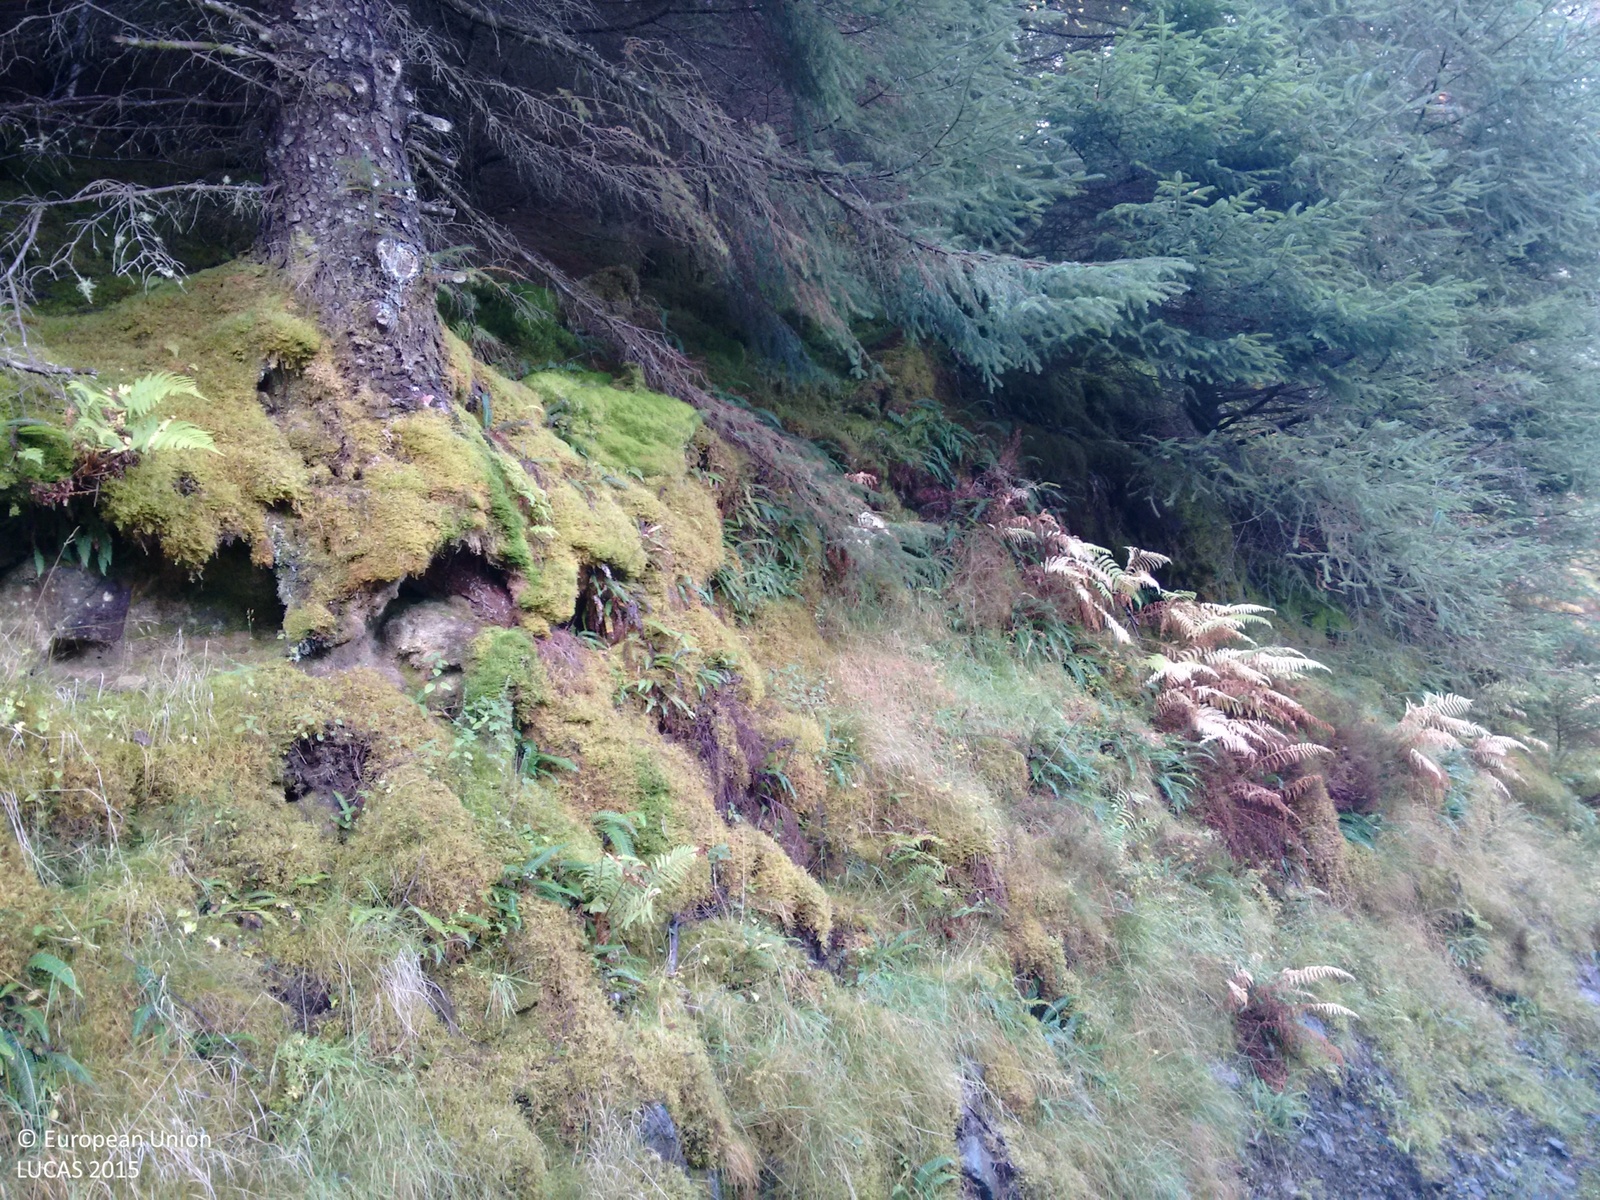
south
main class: Woodland
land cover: Spruce dominated coniferous woodland
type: exotic forest
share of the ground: > 75 %
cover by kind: coniferous forest trees 100 %
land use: Forestry
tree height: > 5 m
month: October
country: GB
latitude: 56.5808
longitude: -5.7720
